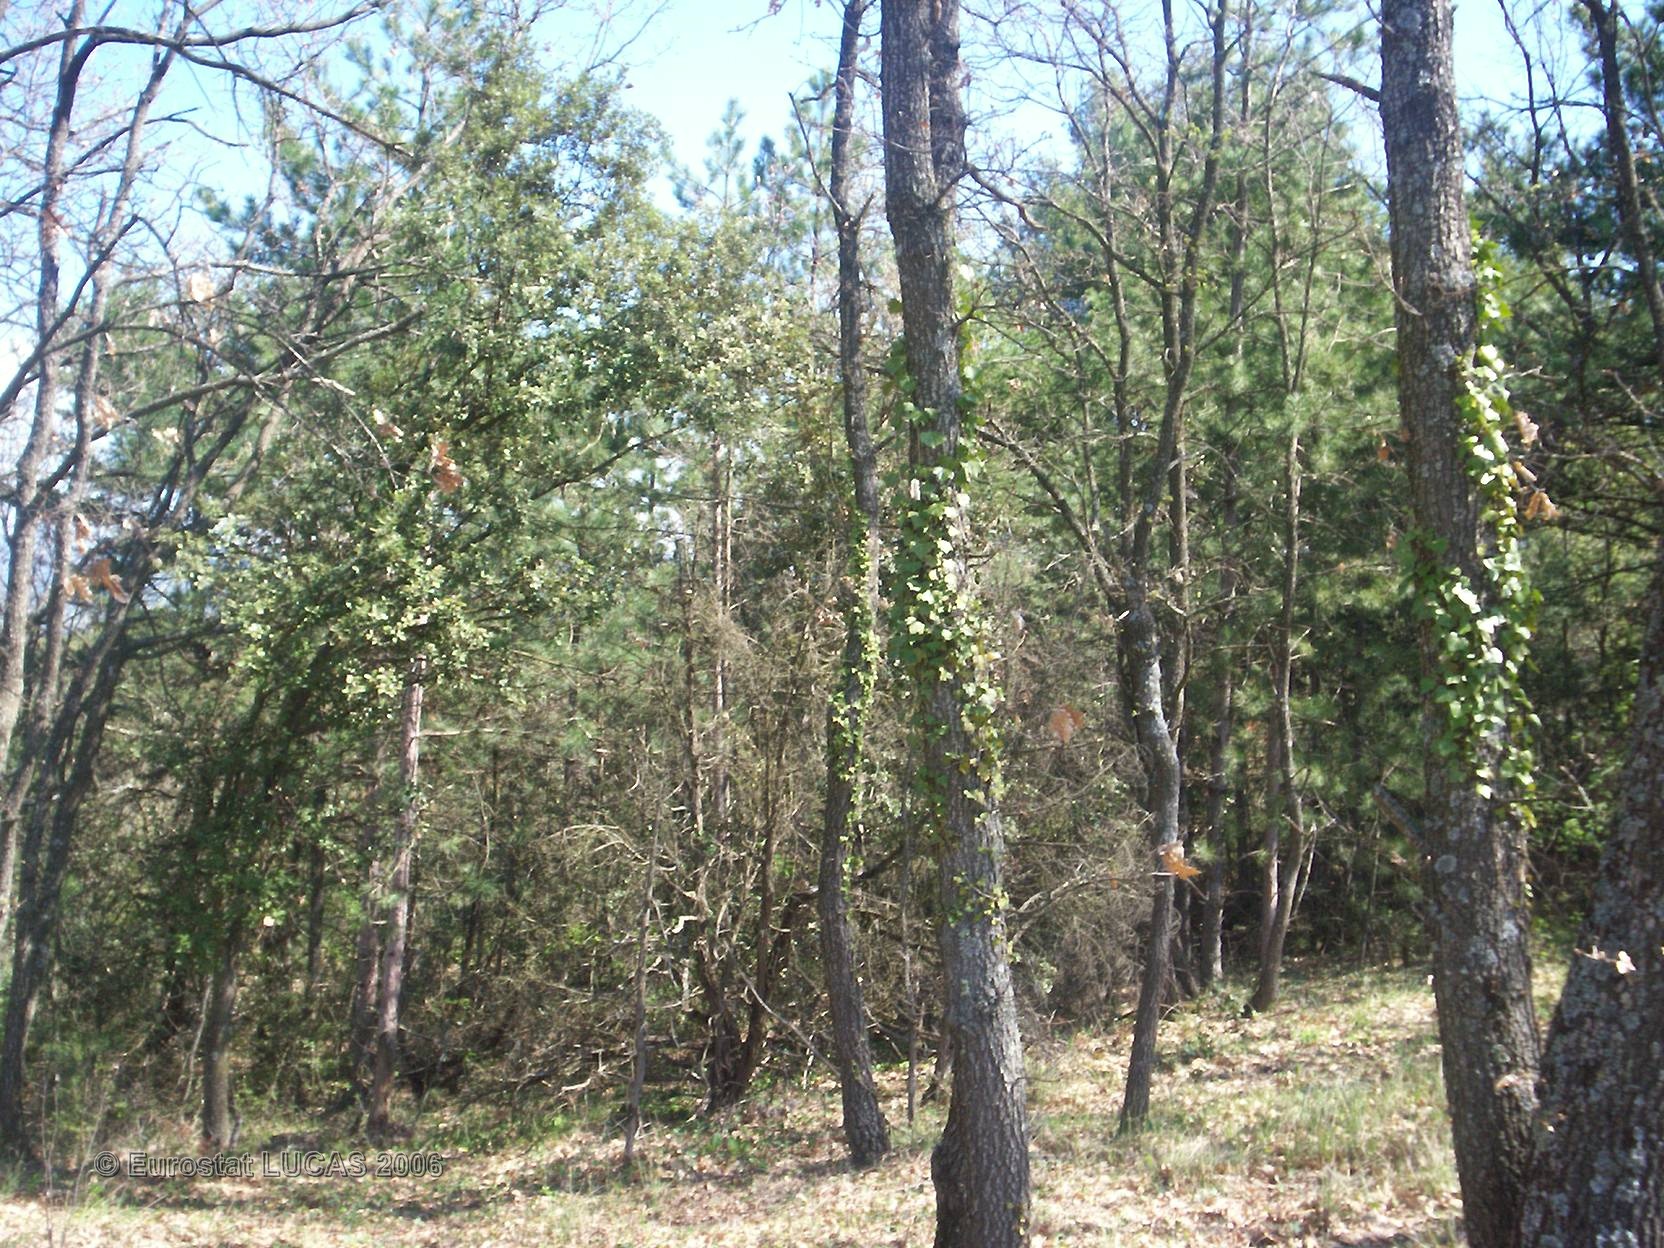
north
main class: Woodland
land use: Forestry
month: April
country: FR
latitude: 43.8475
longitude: 5.3193
